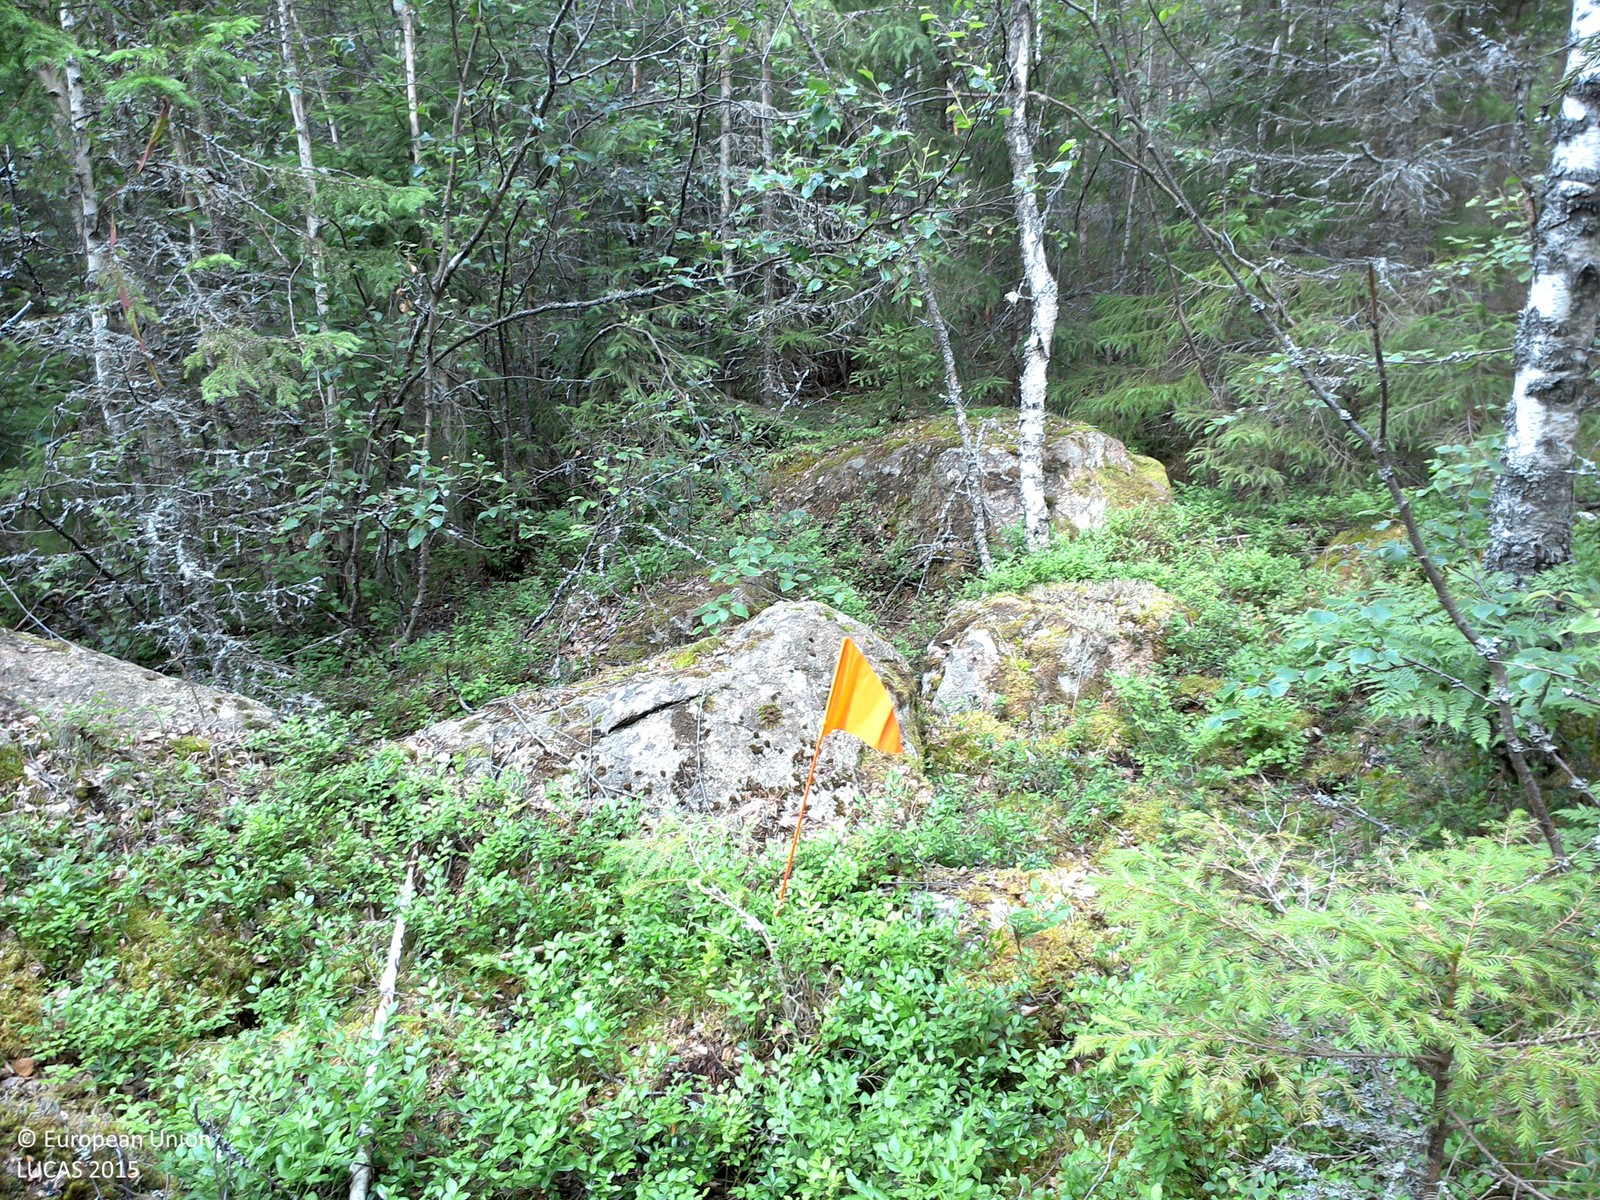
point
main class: Woodland
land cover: Spruce dominated mixed woodland
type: boreal forest
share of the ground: > 75 %
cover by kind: coniferous forest trees 55 %, broadleaved forest trees 20 %, lichens and mosses 20 %, herbaceous plants 5 %
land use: Forestry
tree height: > 5 m
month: July
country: SE
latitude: 58.2259
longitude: 14.7447
